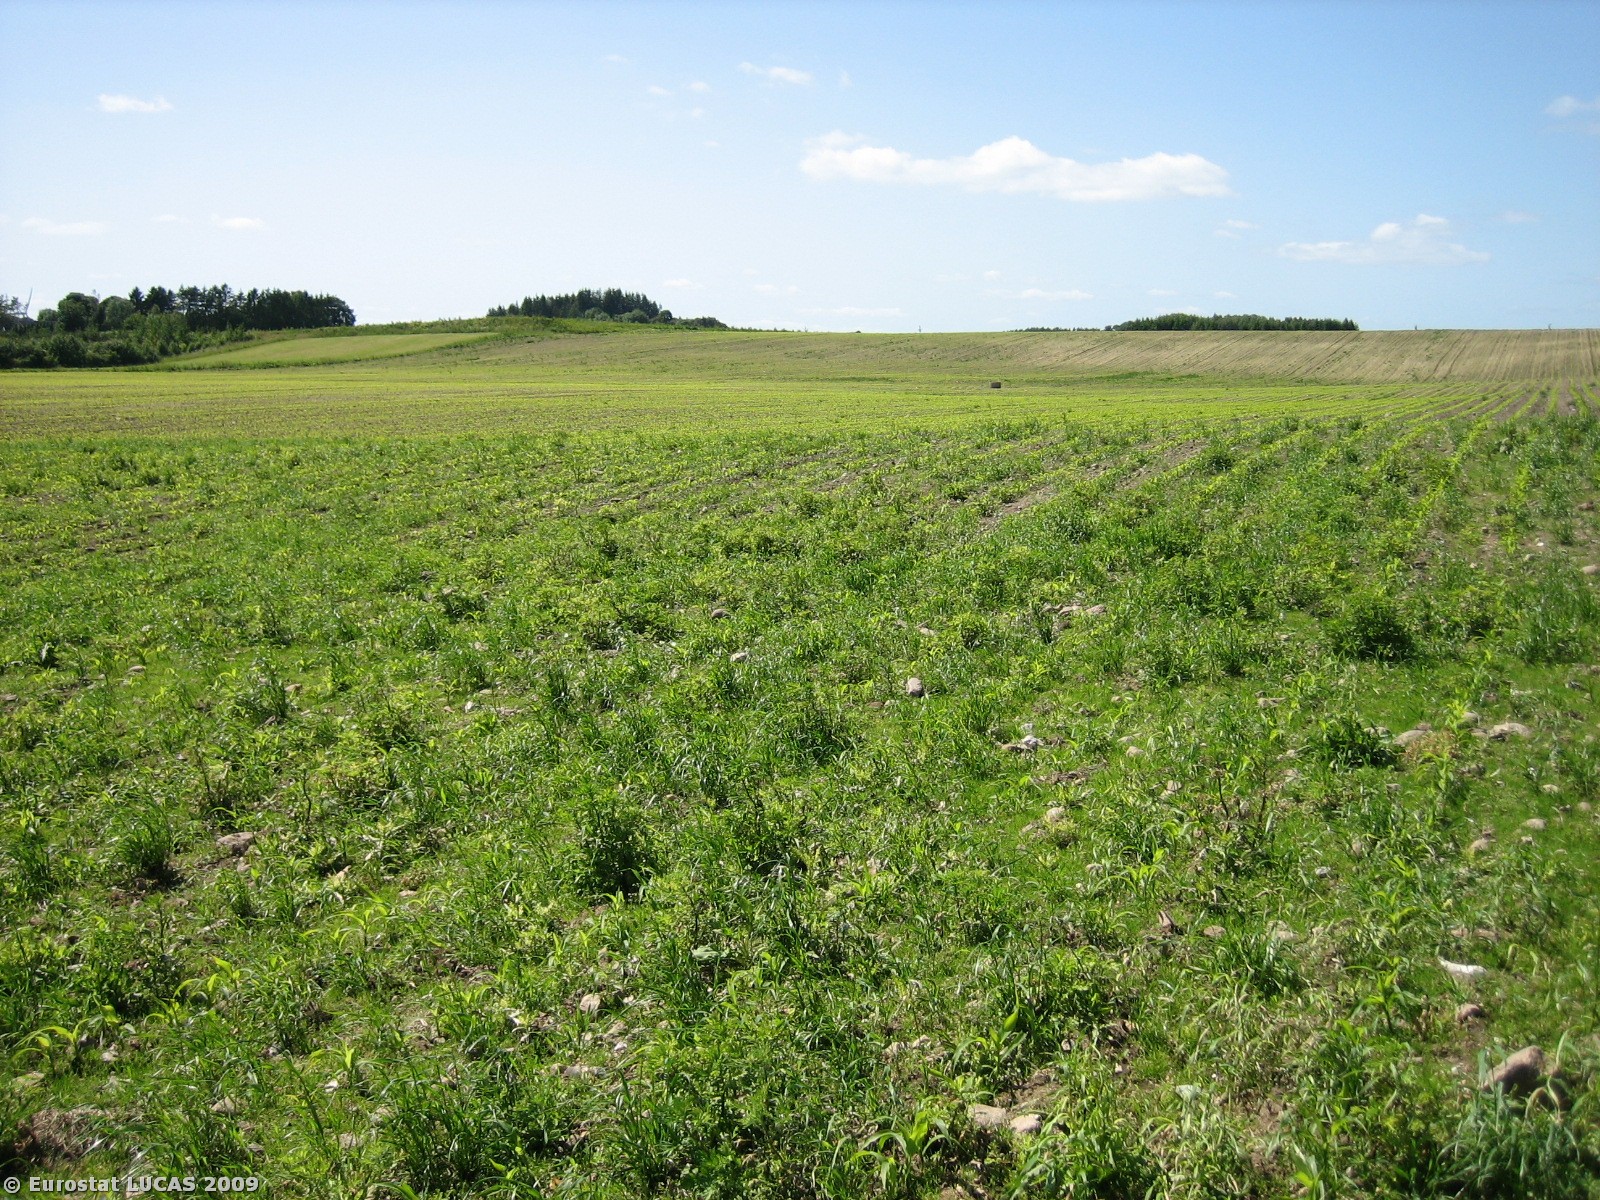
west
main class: Cropland
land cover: Maize
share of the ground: < 10 %
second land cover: Spontaneously vegetated surfaces
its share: 25 - 50 %
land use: Agriculture (excluding fallow land and kitchen gardens)
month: June
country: DK
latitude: 55.9177
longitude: 9.6963
